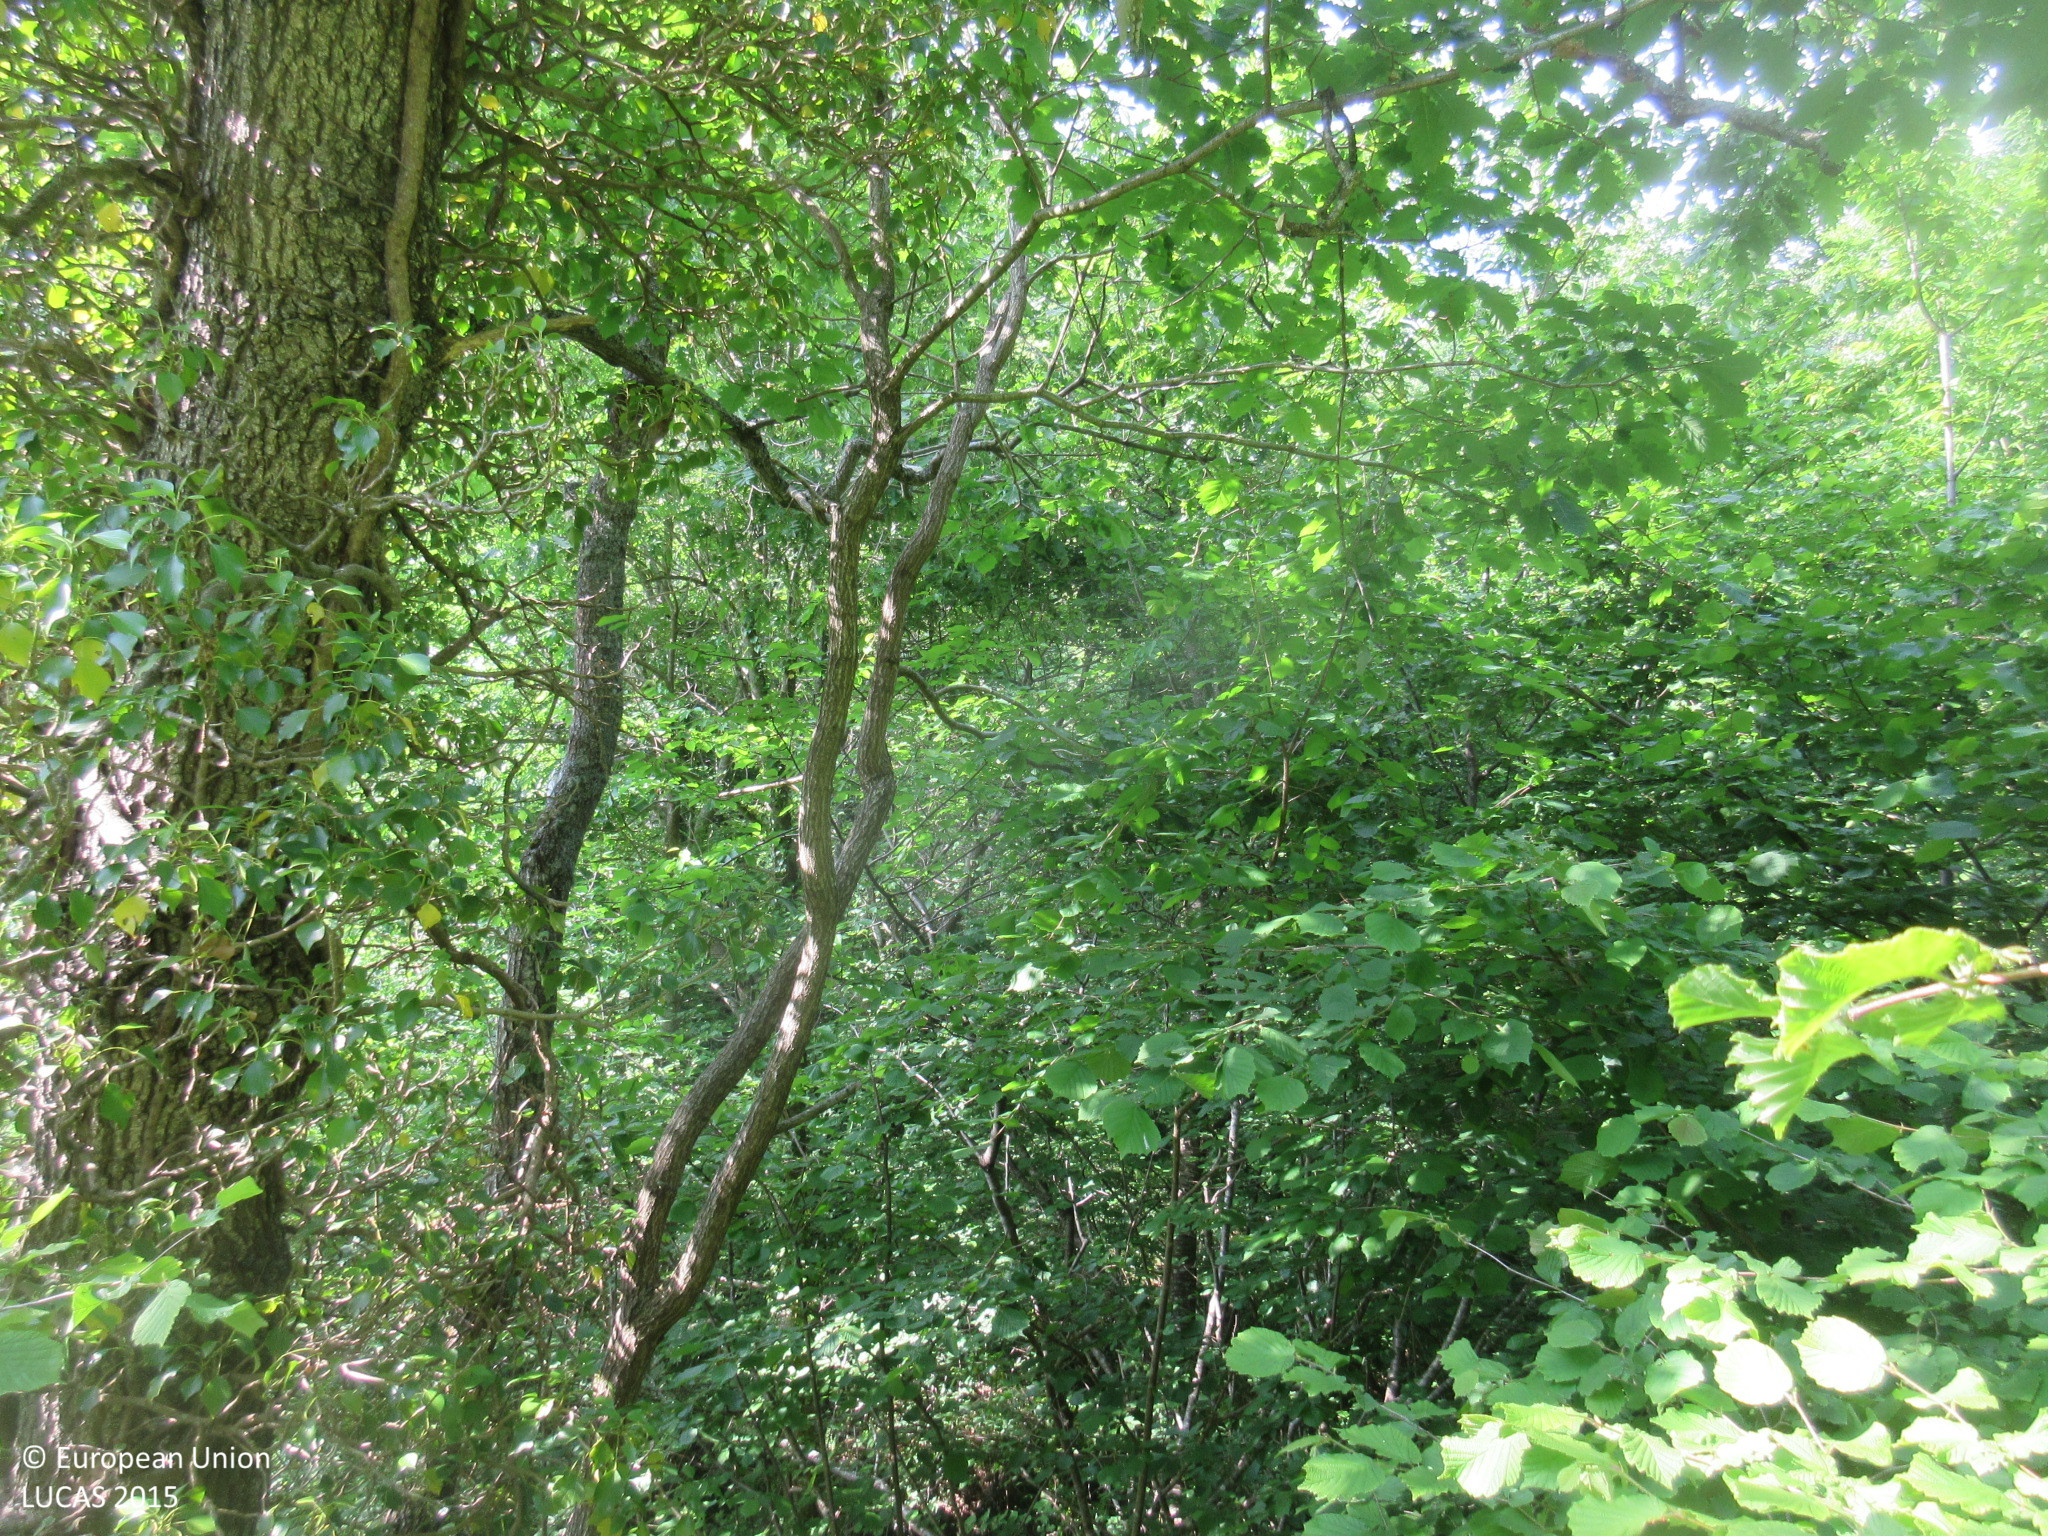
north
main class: Woodland
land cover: Broadleaved woodland
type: mesophytic deciduous forest
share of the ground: > 75 %
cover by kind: broadleaved forest trees 100 %
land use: Semi-natural and natural areas not in use
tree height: > 5 m
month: May
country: ES
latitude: 43.1881
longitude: -4.5665
